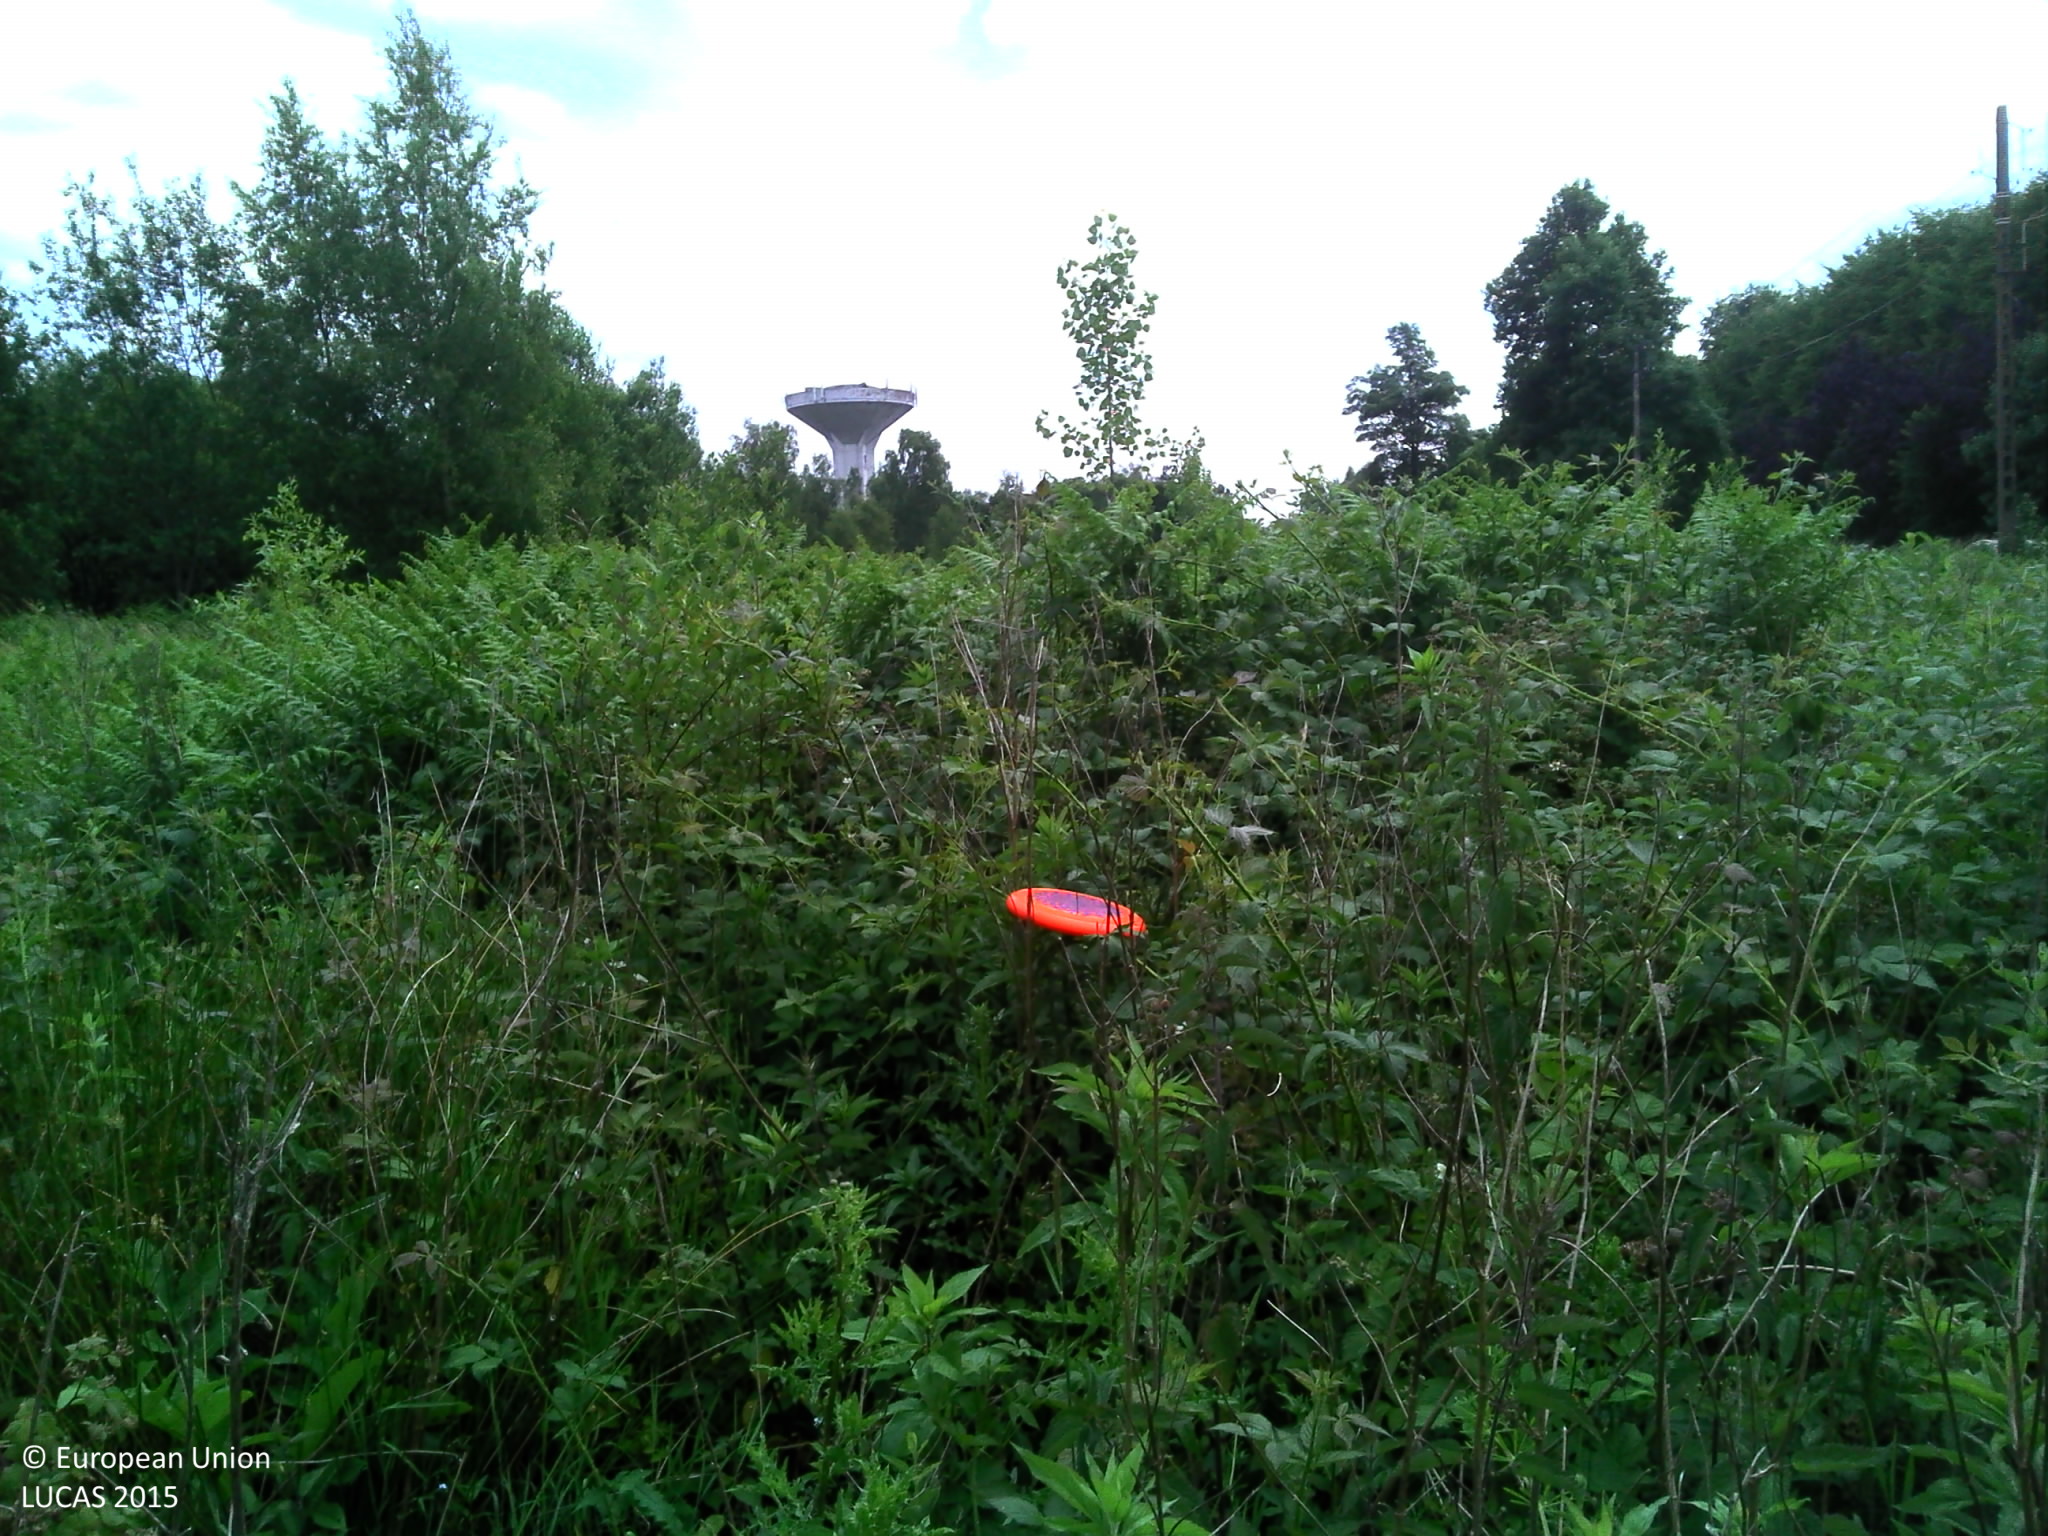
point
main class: Shrubland
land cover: Shrubland with sparse tree cover
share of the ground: > 75 %
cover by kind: shrubs 70 %, herbaceous plants 25 %, broadleaved forest trees 5 %
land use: Semi-natural and natural areas not in use
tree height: < 5 m
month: June
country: BE
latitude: 50.5042
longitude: 3.8321
